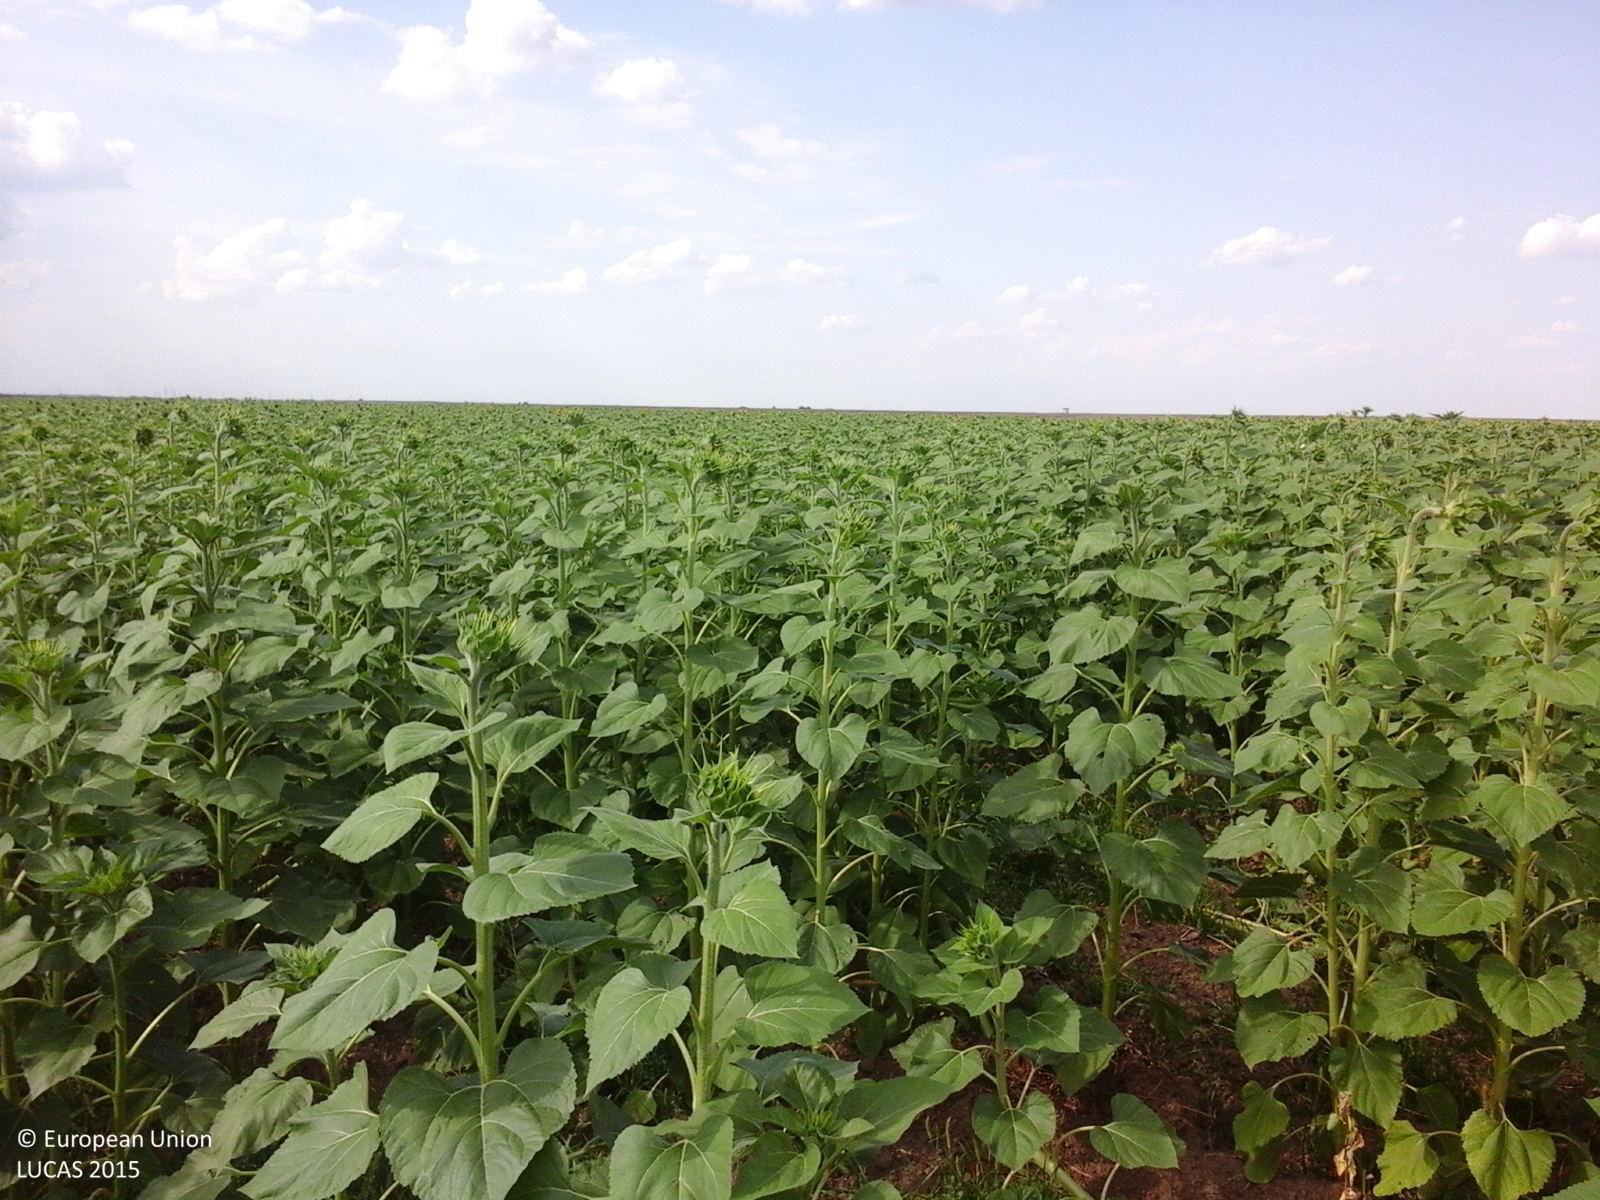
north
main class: Cropland
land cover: Common wheat
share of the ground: > 75 %
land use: Agriculture (excluding fallow land and kitchen gardens)
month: June
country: RO
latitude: 44.2571
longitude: 26.2261
